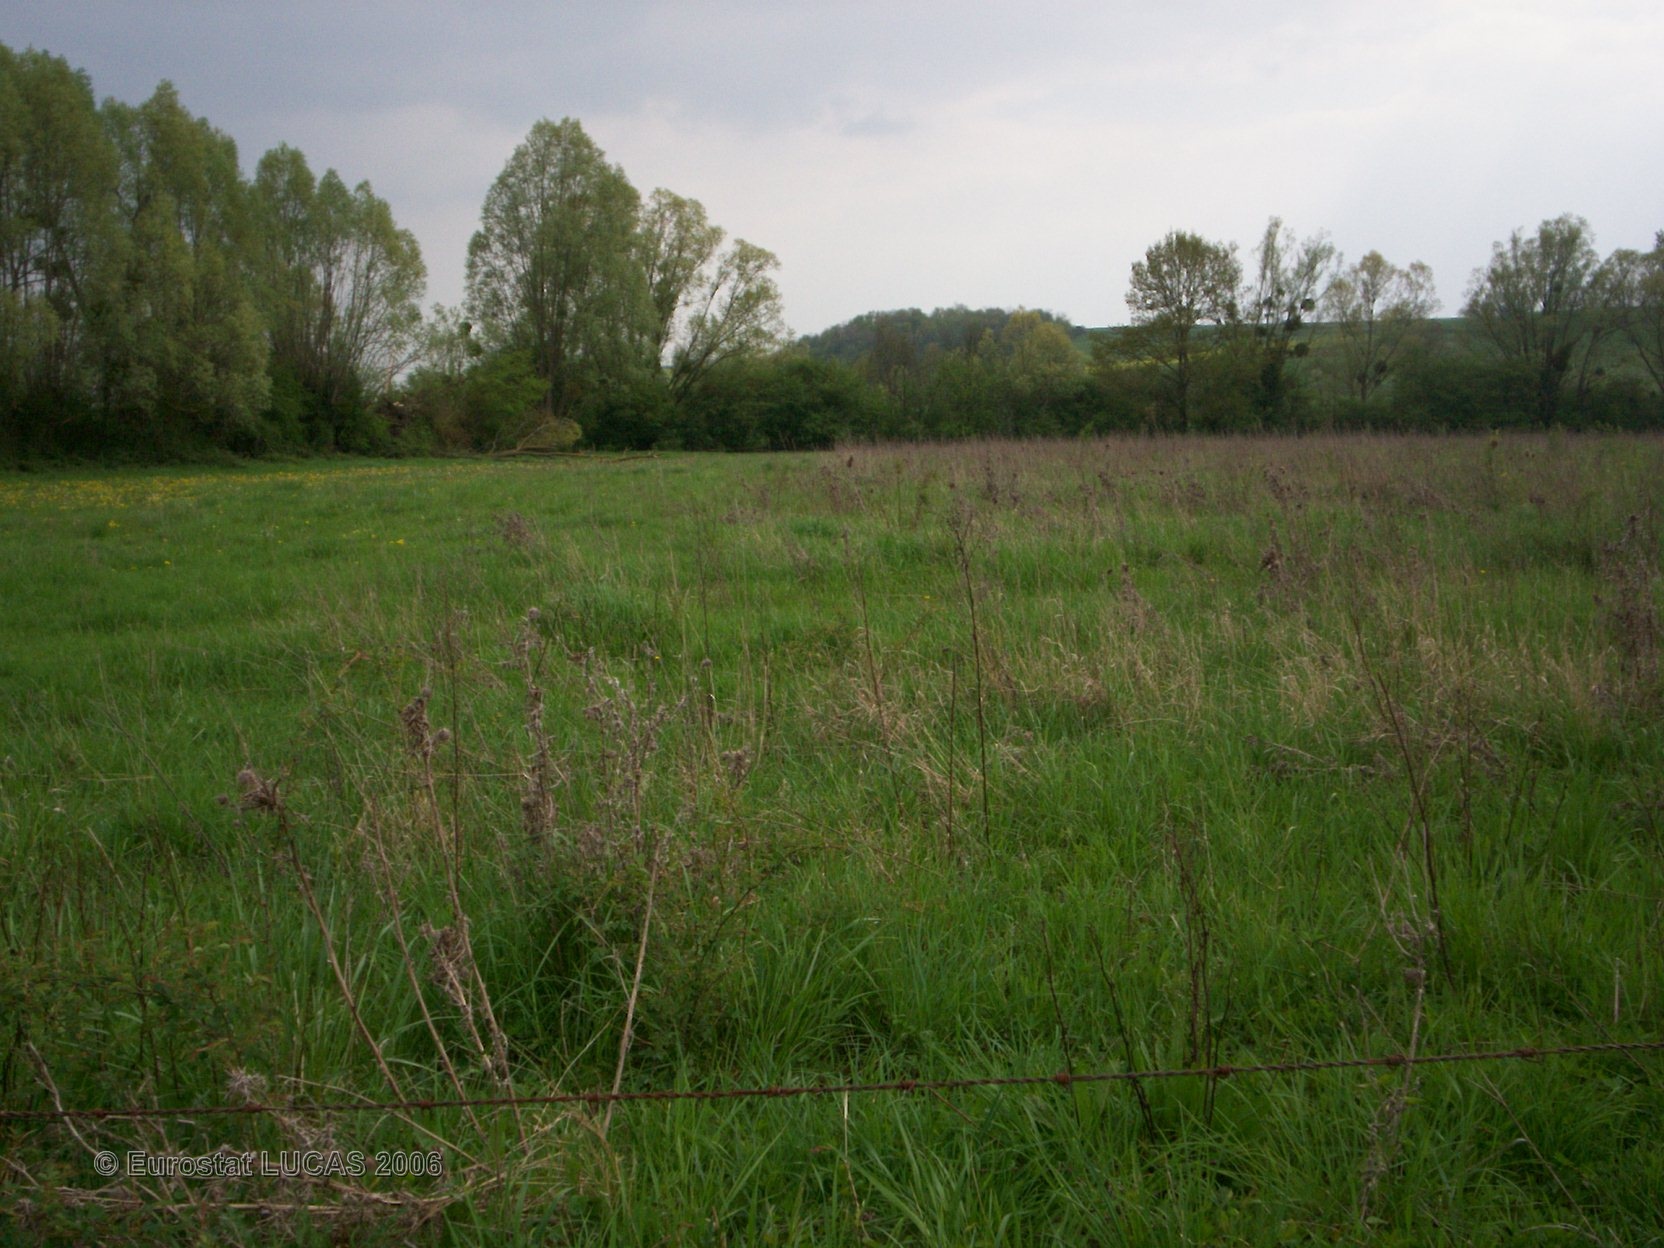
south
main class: Grassland
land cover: Grassland with sparse tree/shrub cover
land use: Agriculture (excluding fallow land and kitchen gardens)
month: April
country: FR
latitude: 47.0831
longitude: 3.0542
